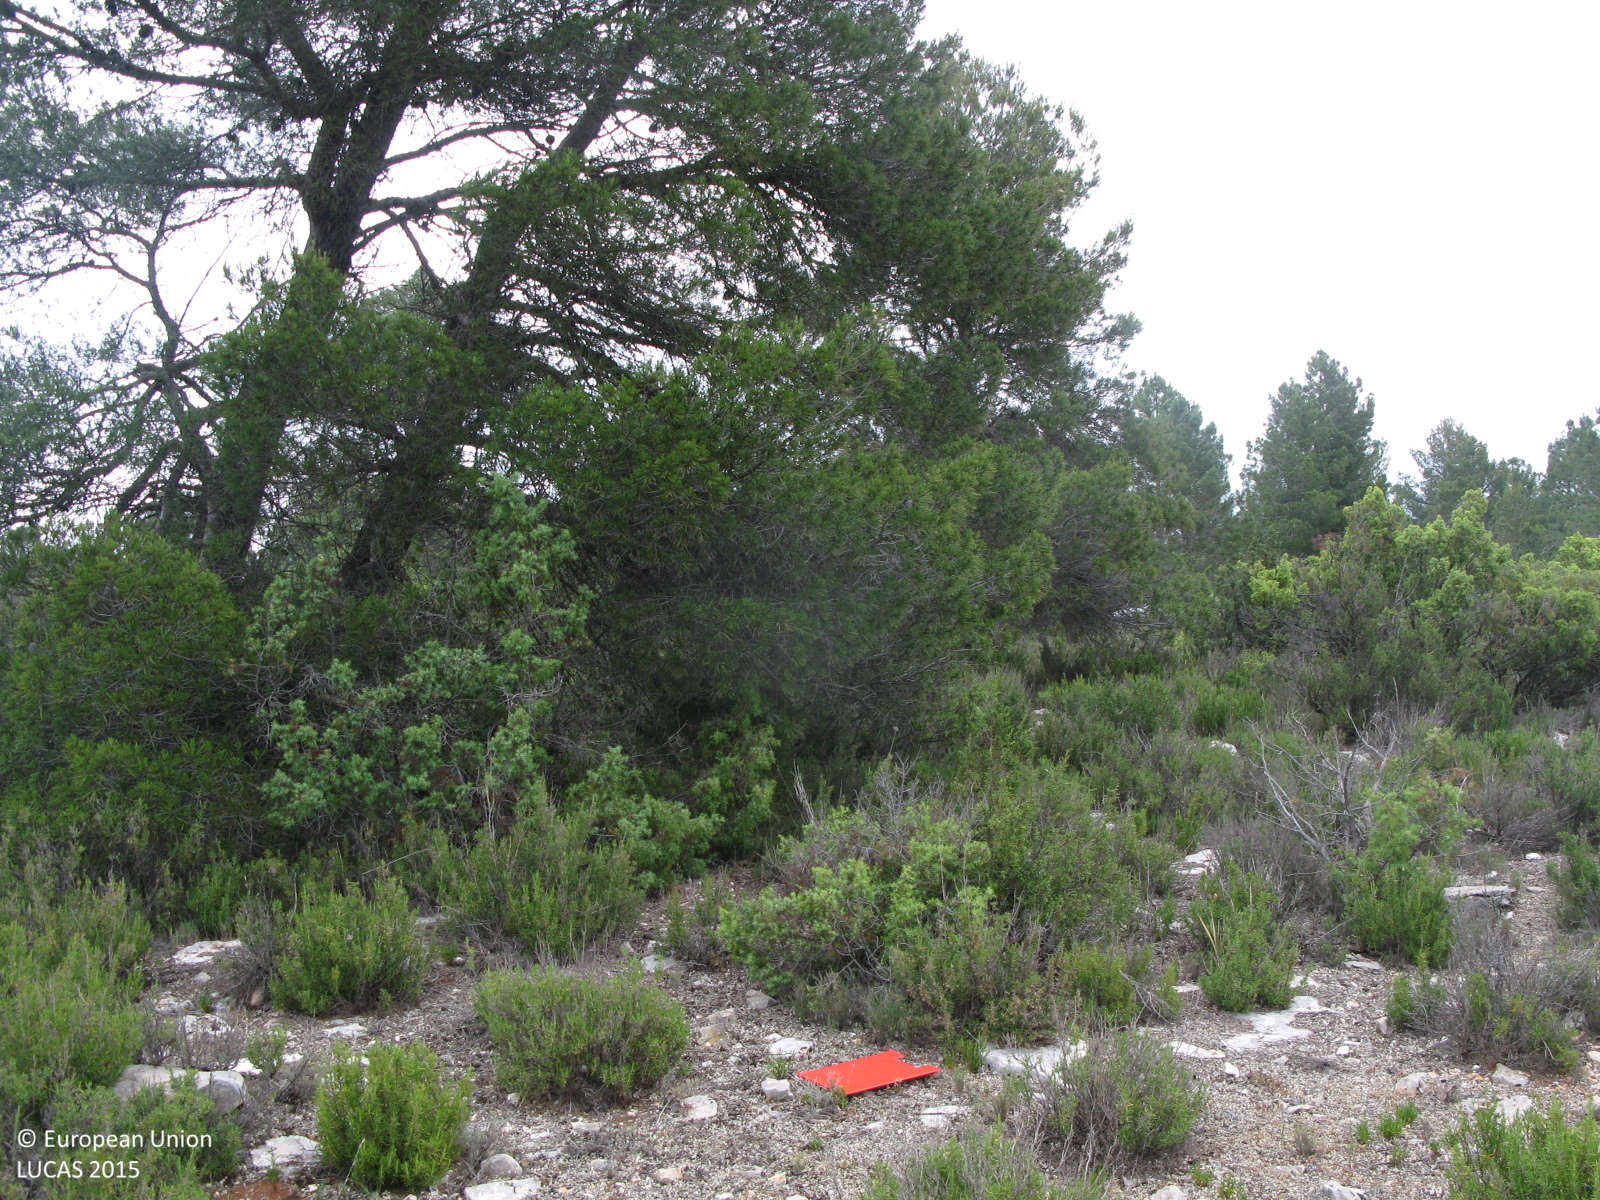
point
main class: Woodland
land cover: Pine dominated coniferous woodland
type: coniferous forest of the mediterranean region
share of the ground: 10 - 25 %
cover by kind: consolidated bare surface 40 %, shrubs 20 %, lichens and mosses 20 %, coniferous forest trees 15 %, herbaceous plants 5 %
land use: Forestry
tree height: > 5 m
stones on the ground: > 50 %
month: June
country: ES
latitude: 39.9209
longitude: -1.1563
